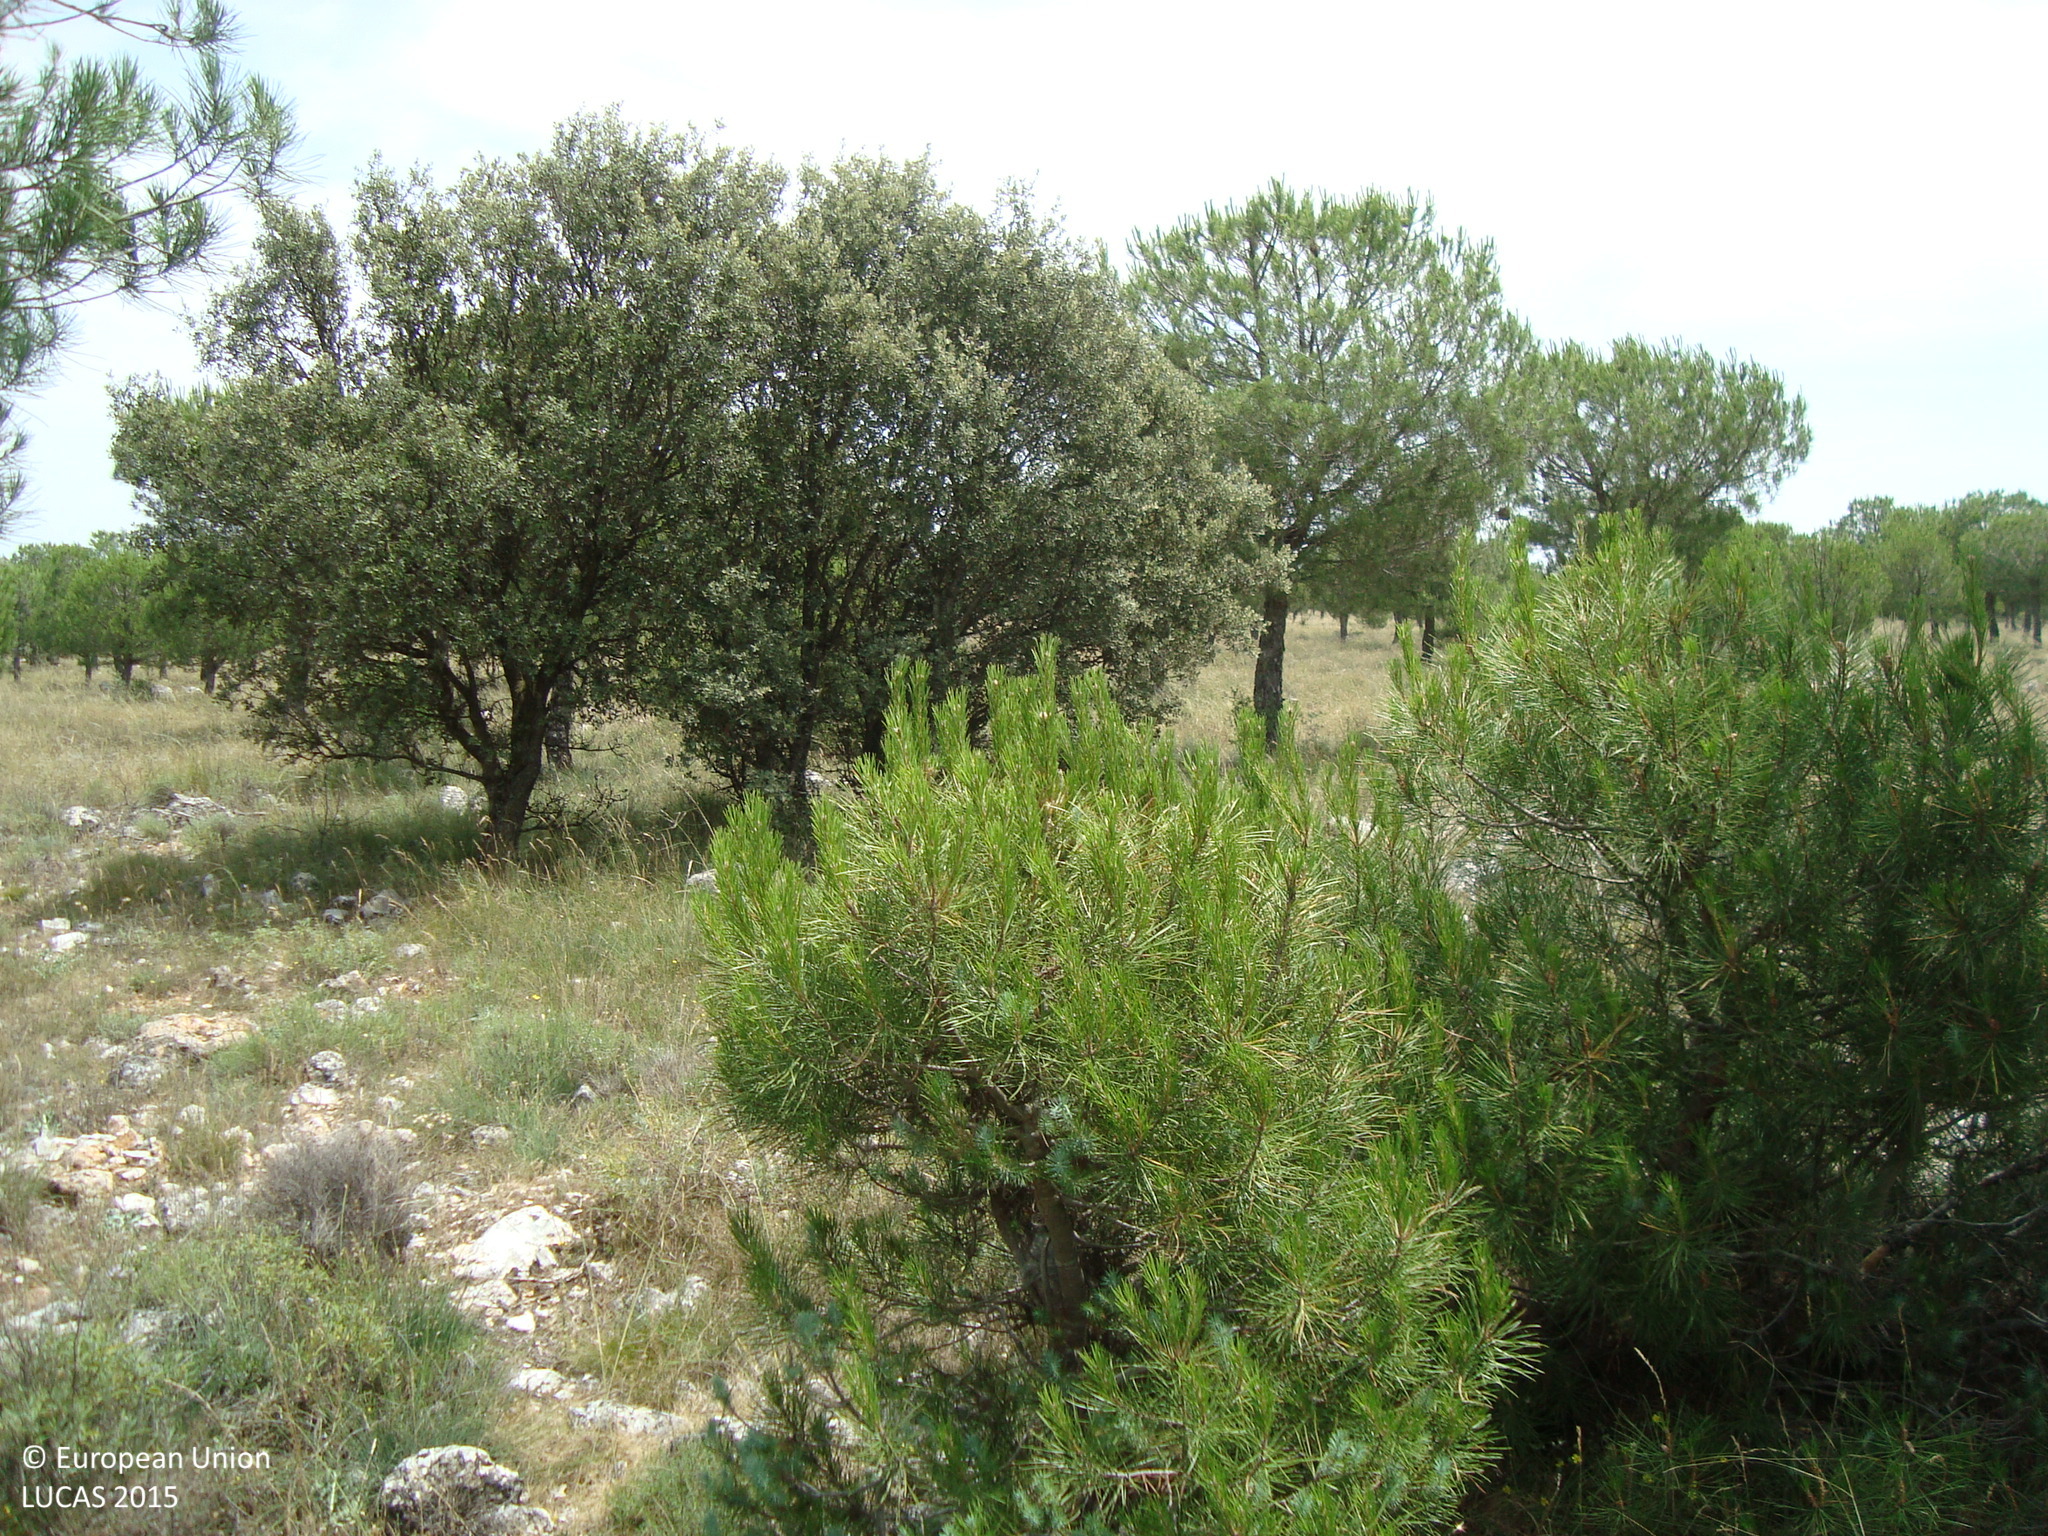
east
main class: Woodland
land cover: Pine dominated coniferous woodland
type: coniferous forest of the mediterranean region
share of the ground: 10 - 25 %
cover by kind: shrubs 60 %, coniferous forest trees 20 %, herbaceous plants 10 %, broadleaved forest trees 5 %, unconsolidated bare surface 5 %
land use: Forestry
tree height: > 5 m
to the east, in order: Pine dominated coniferous woodland
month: July
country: ES
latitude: 41.8041
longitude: -4.1311
